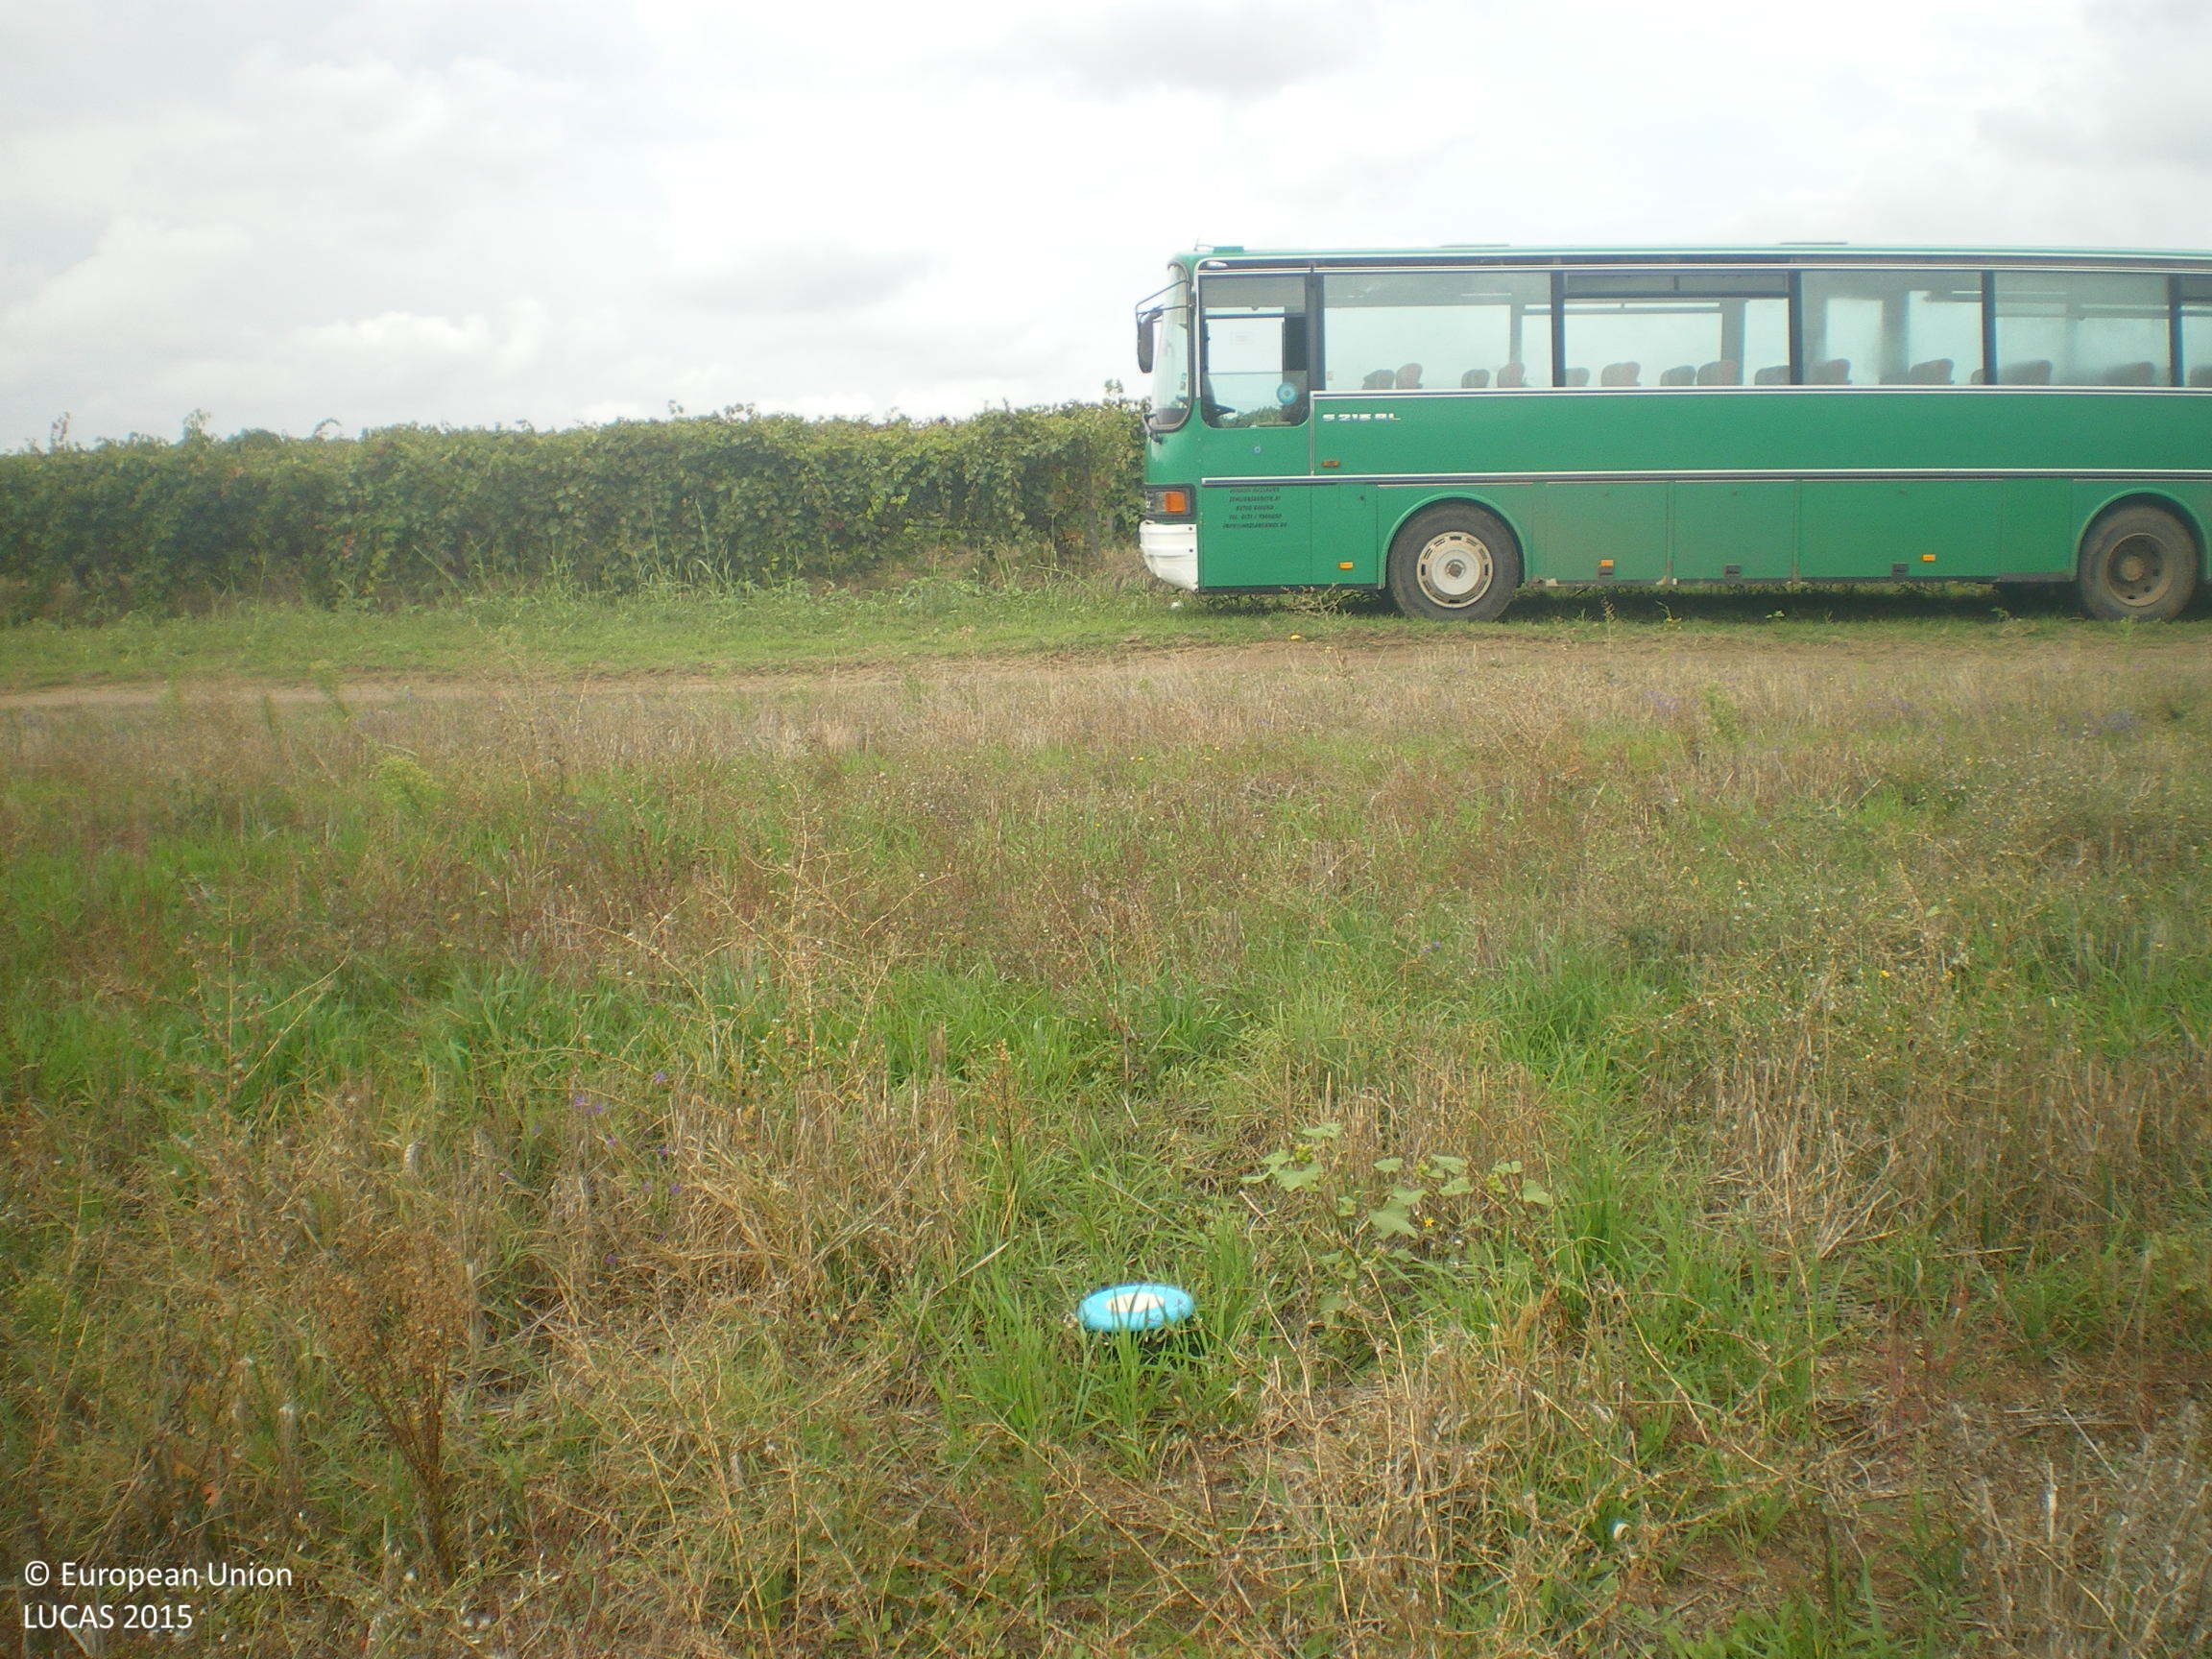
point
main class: Cropland
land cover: Common wheat
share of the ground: < 10 %
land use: Agriculture (excluding fallow land and kitchen gardens)
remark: Harvested field
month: October
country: BG
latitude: 41.9509
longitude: 26.0593
